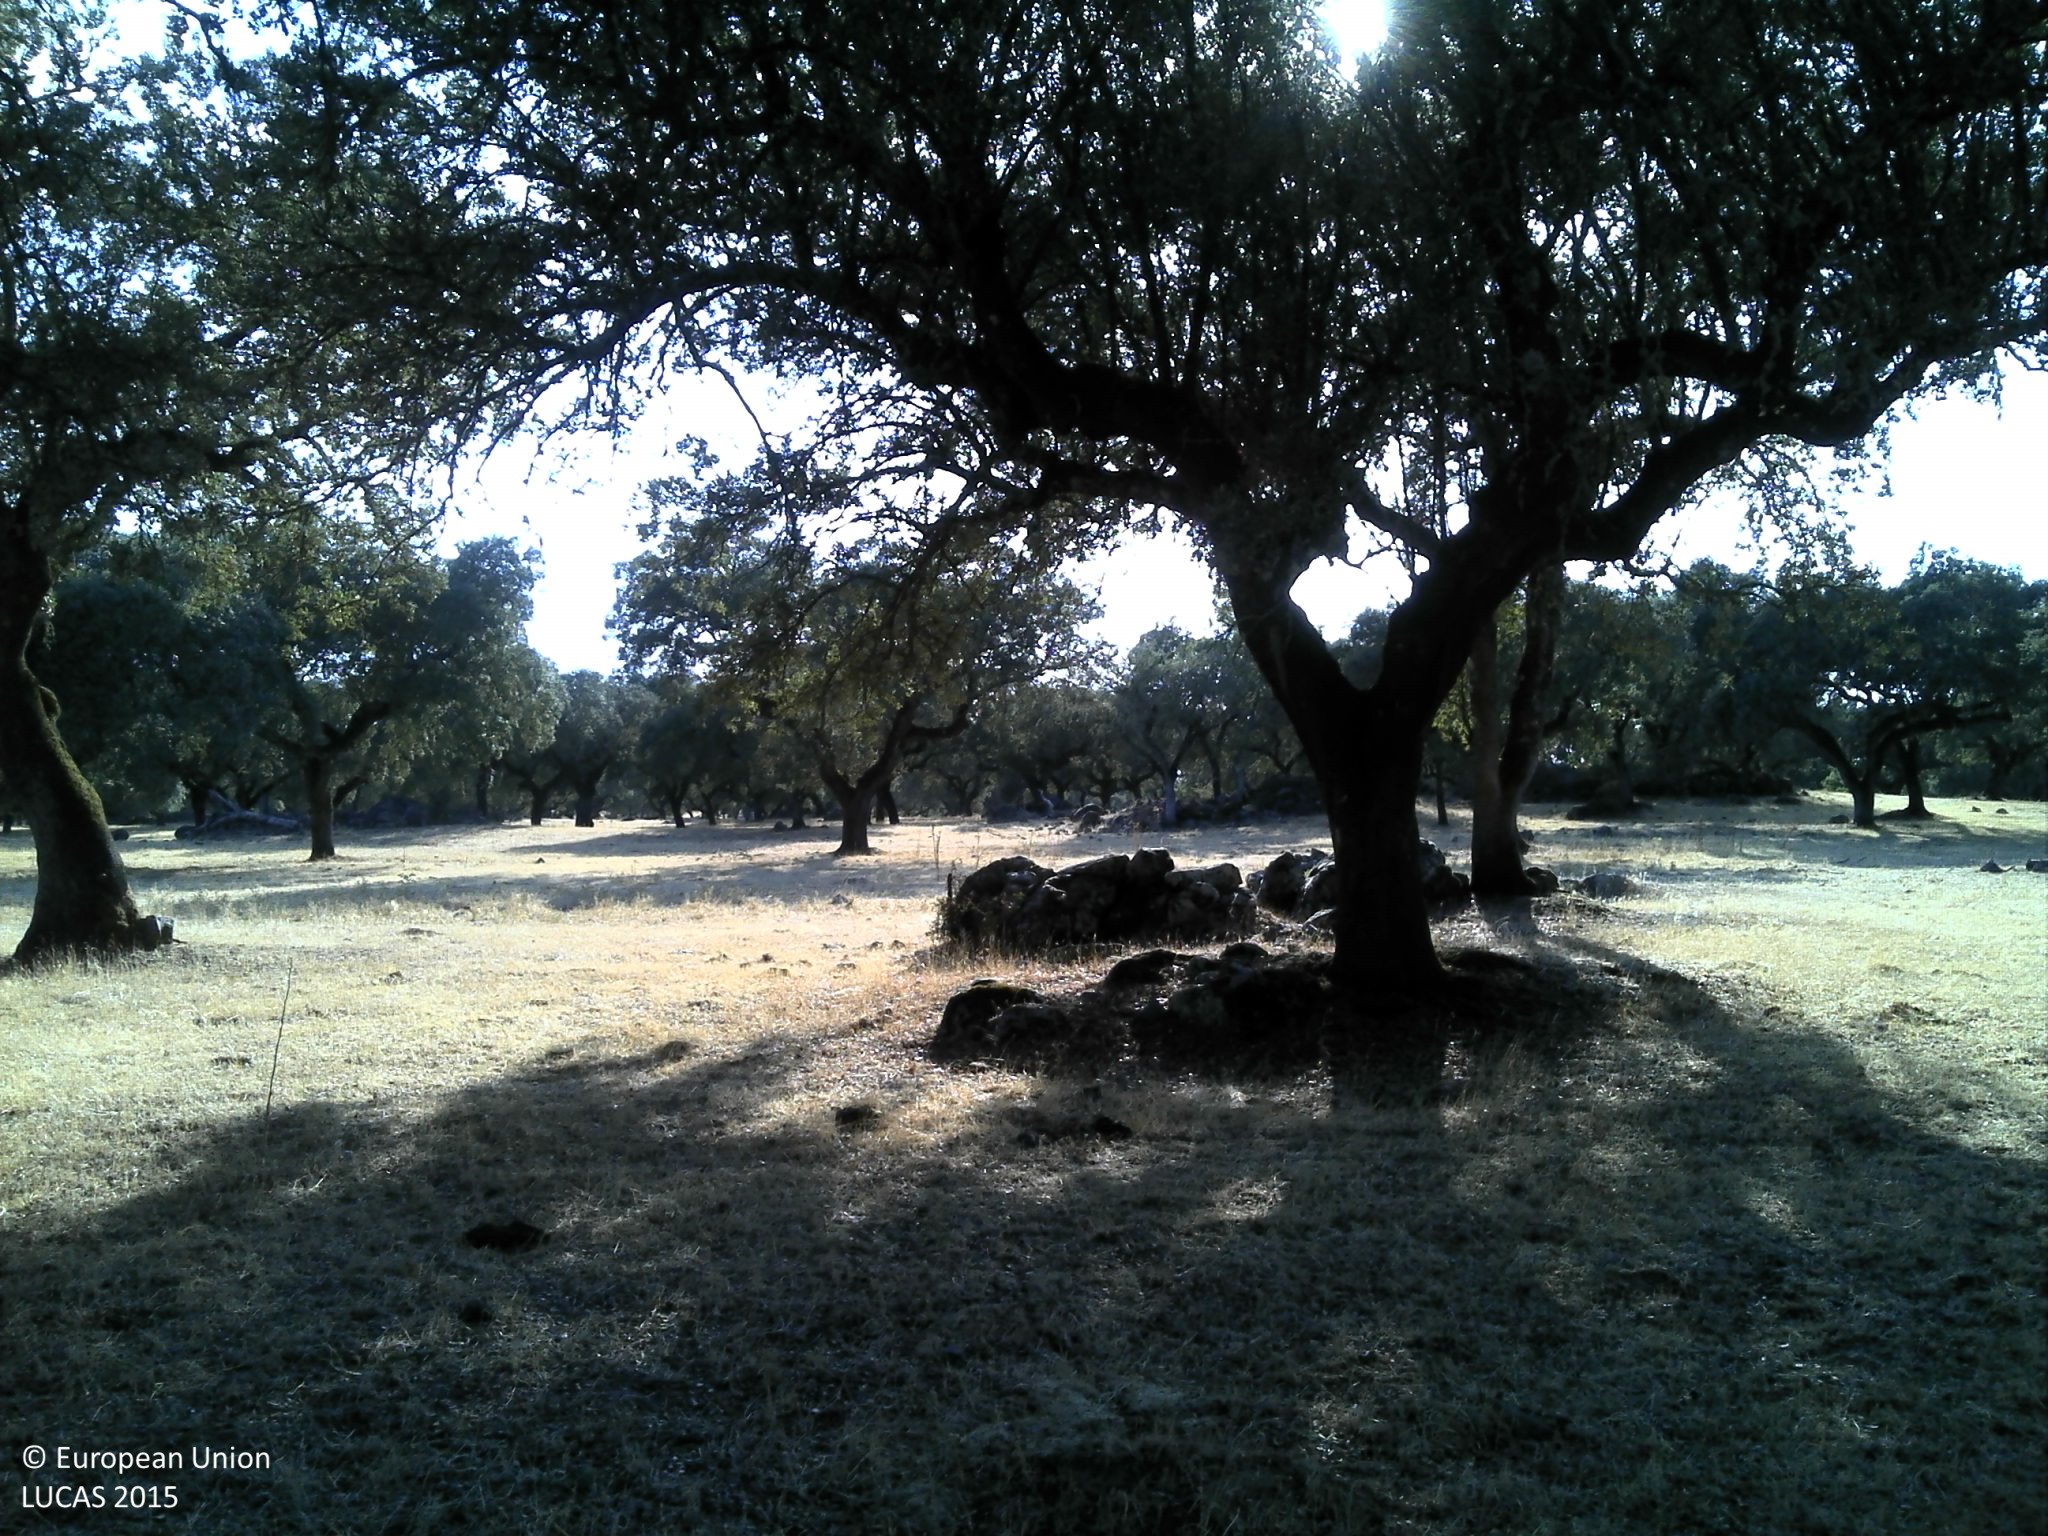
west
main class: Woodland
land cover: Broadleaved woodland
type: broadleaved evergreen forest
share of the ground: 25 - 50 %
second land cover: Grassland without tree/shrub cover
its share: 10 - 25 %
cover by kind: unconsolidated bare surface 55 %, broadleaved forest trees 30 %, herbaceous plants 15 %
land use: Forestry
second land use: Agriculture (excluding fallow land and kitchen gardens)
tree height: > 5 m
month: August
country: PT
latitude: 39.3181
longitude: -7.5473
